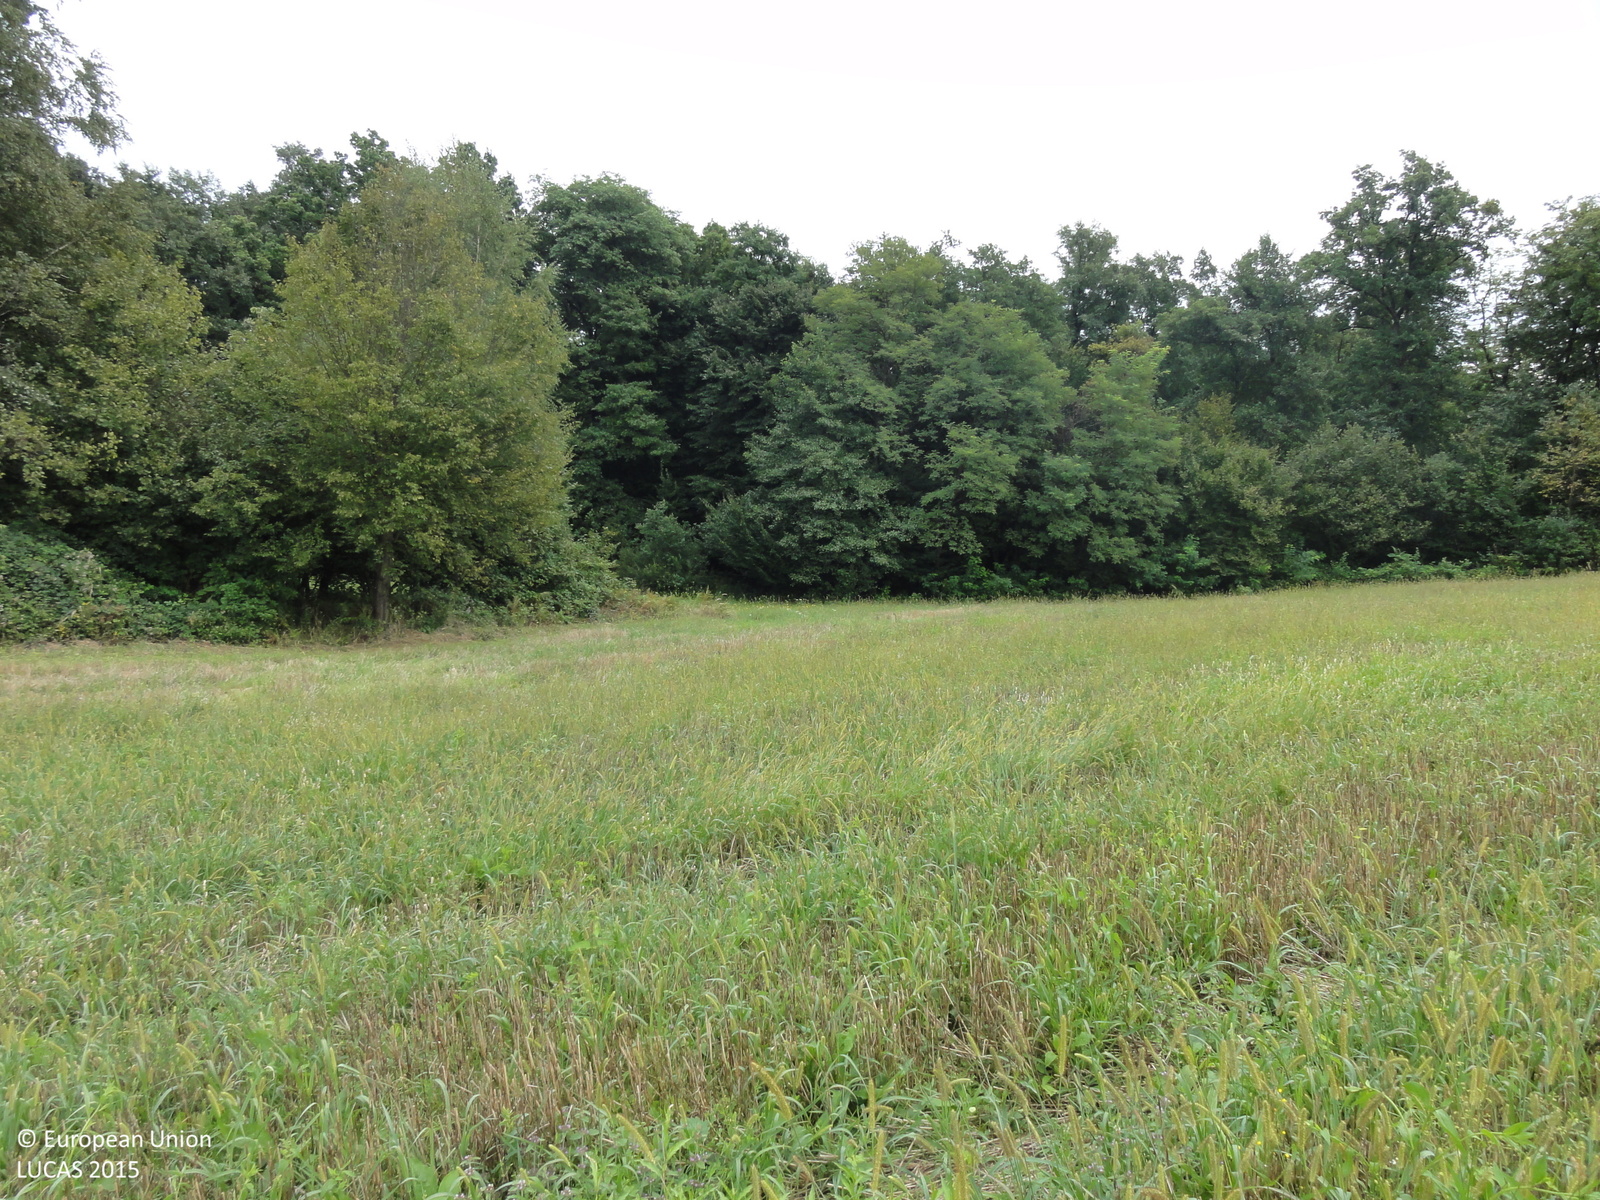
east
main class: Cropland
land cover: Common wheat
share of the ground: < 10 %
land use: Agriculture (excluding fallow land and kitchen gardens)
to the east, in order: Common wheat; Grassland without tree/shrub cover; Broadleaved woodland; Rivers and streams; Broadleaved woodland; Rivers and streams; Broadleaved woodland; Grassland without tree/shrub cover
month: August
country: SI
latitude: 45.9413
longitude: 15.4535
